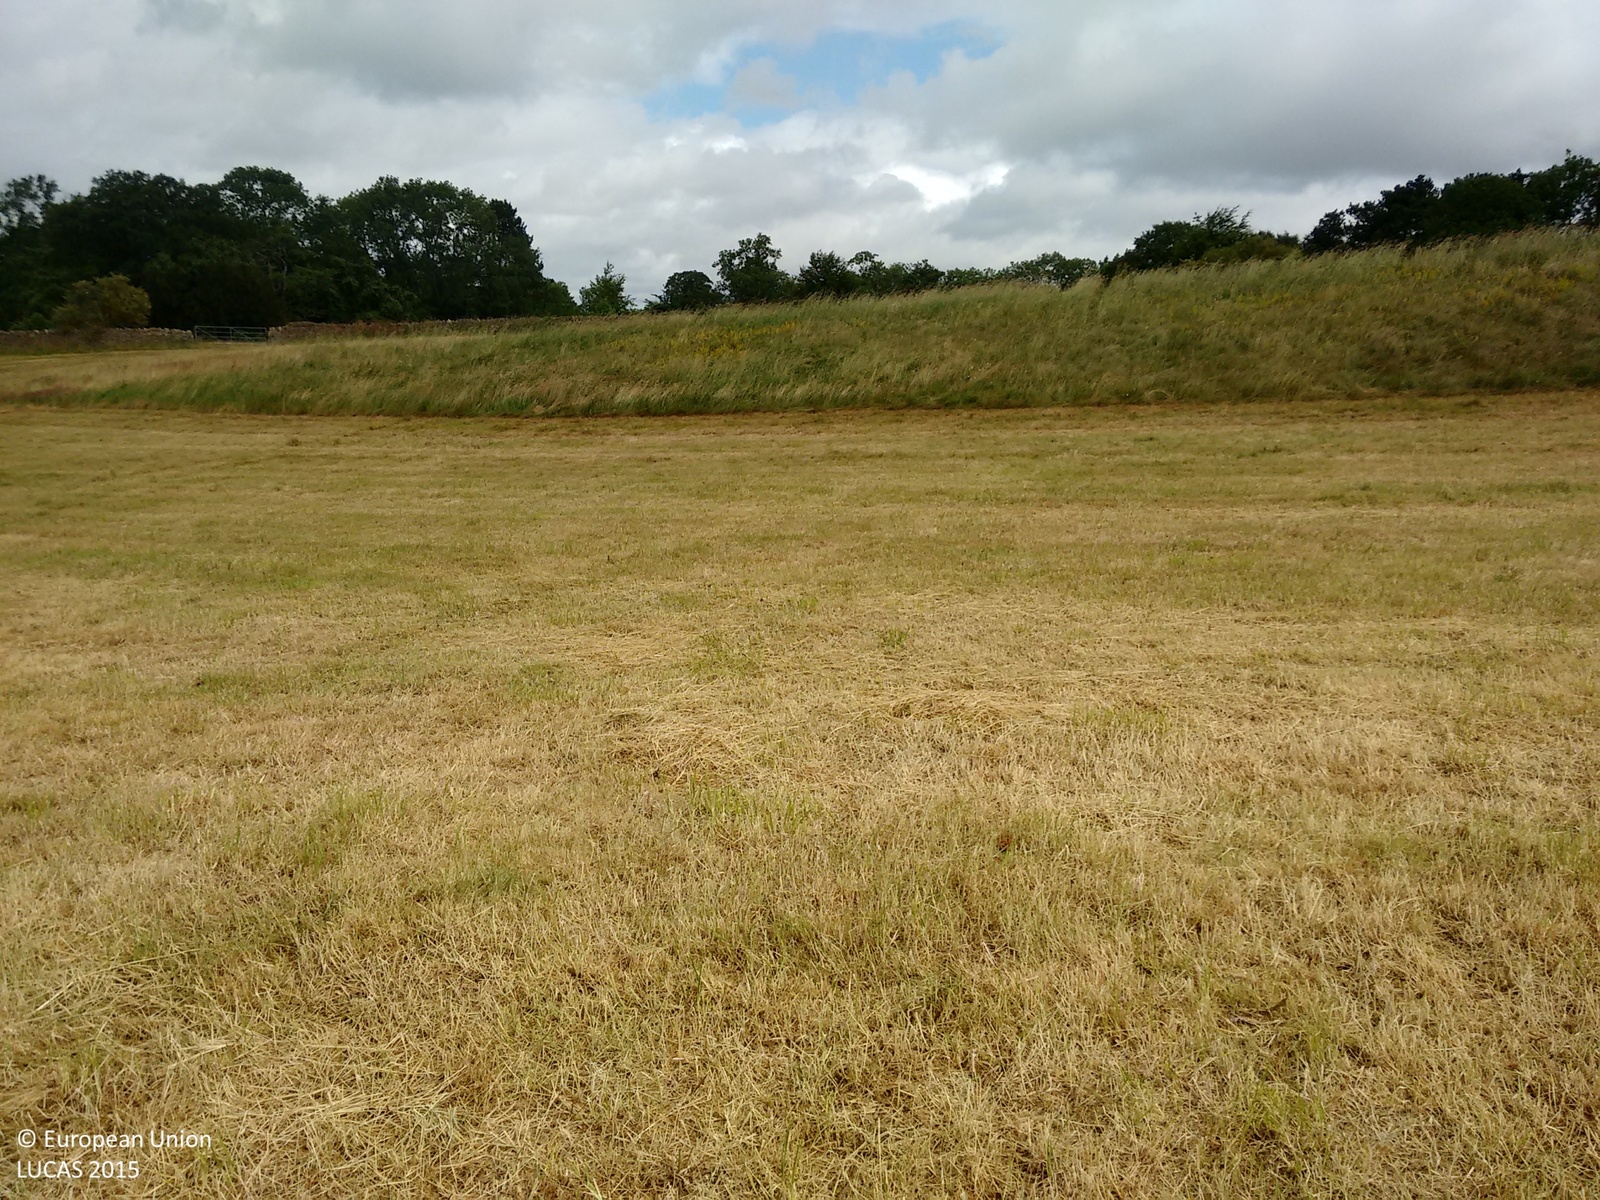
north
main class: Grassland
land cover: Grassland without tree/shrub cover
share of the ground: > 75 %
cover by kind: herbaceous plants 100 %
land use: Residential
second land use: Agriculture (excluding fallow land and kitchen gardens)
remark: Harvested field
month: July
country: GB
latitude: 51.8997
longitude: -1.5771
